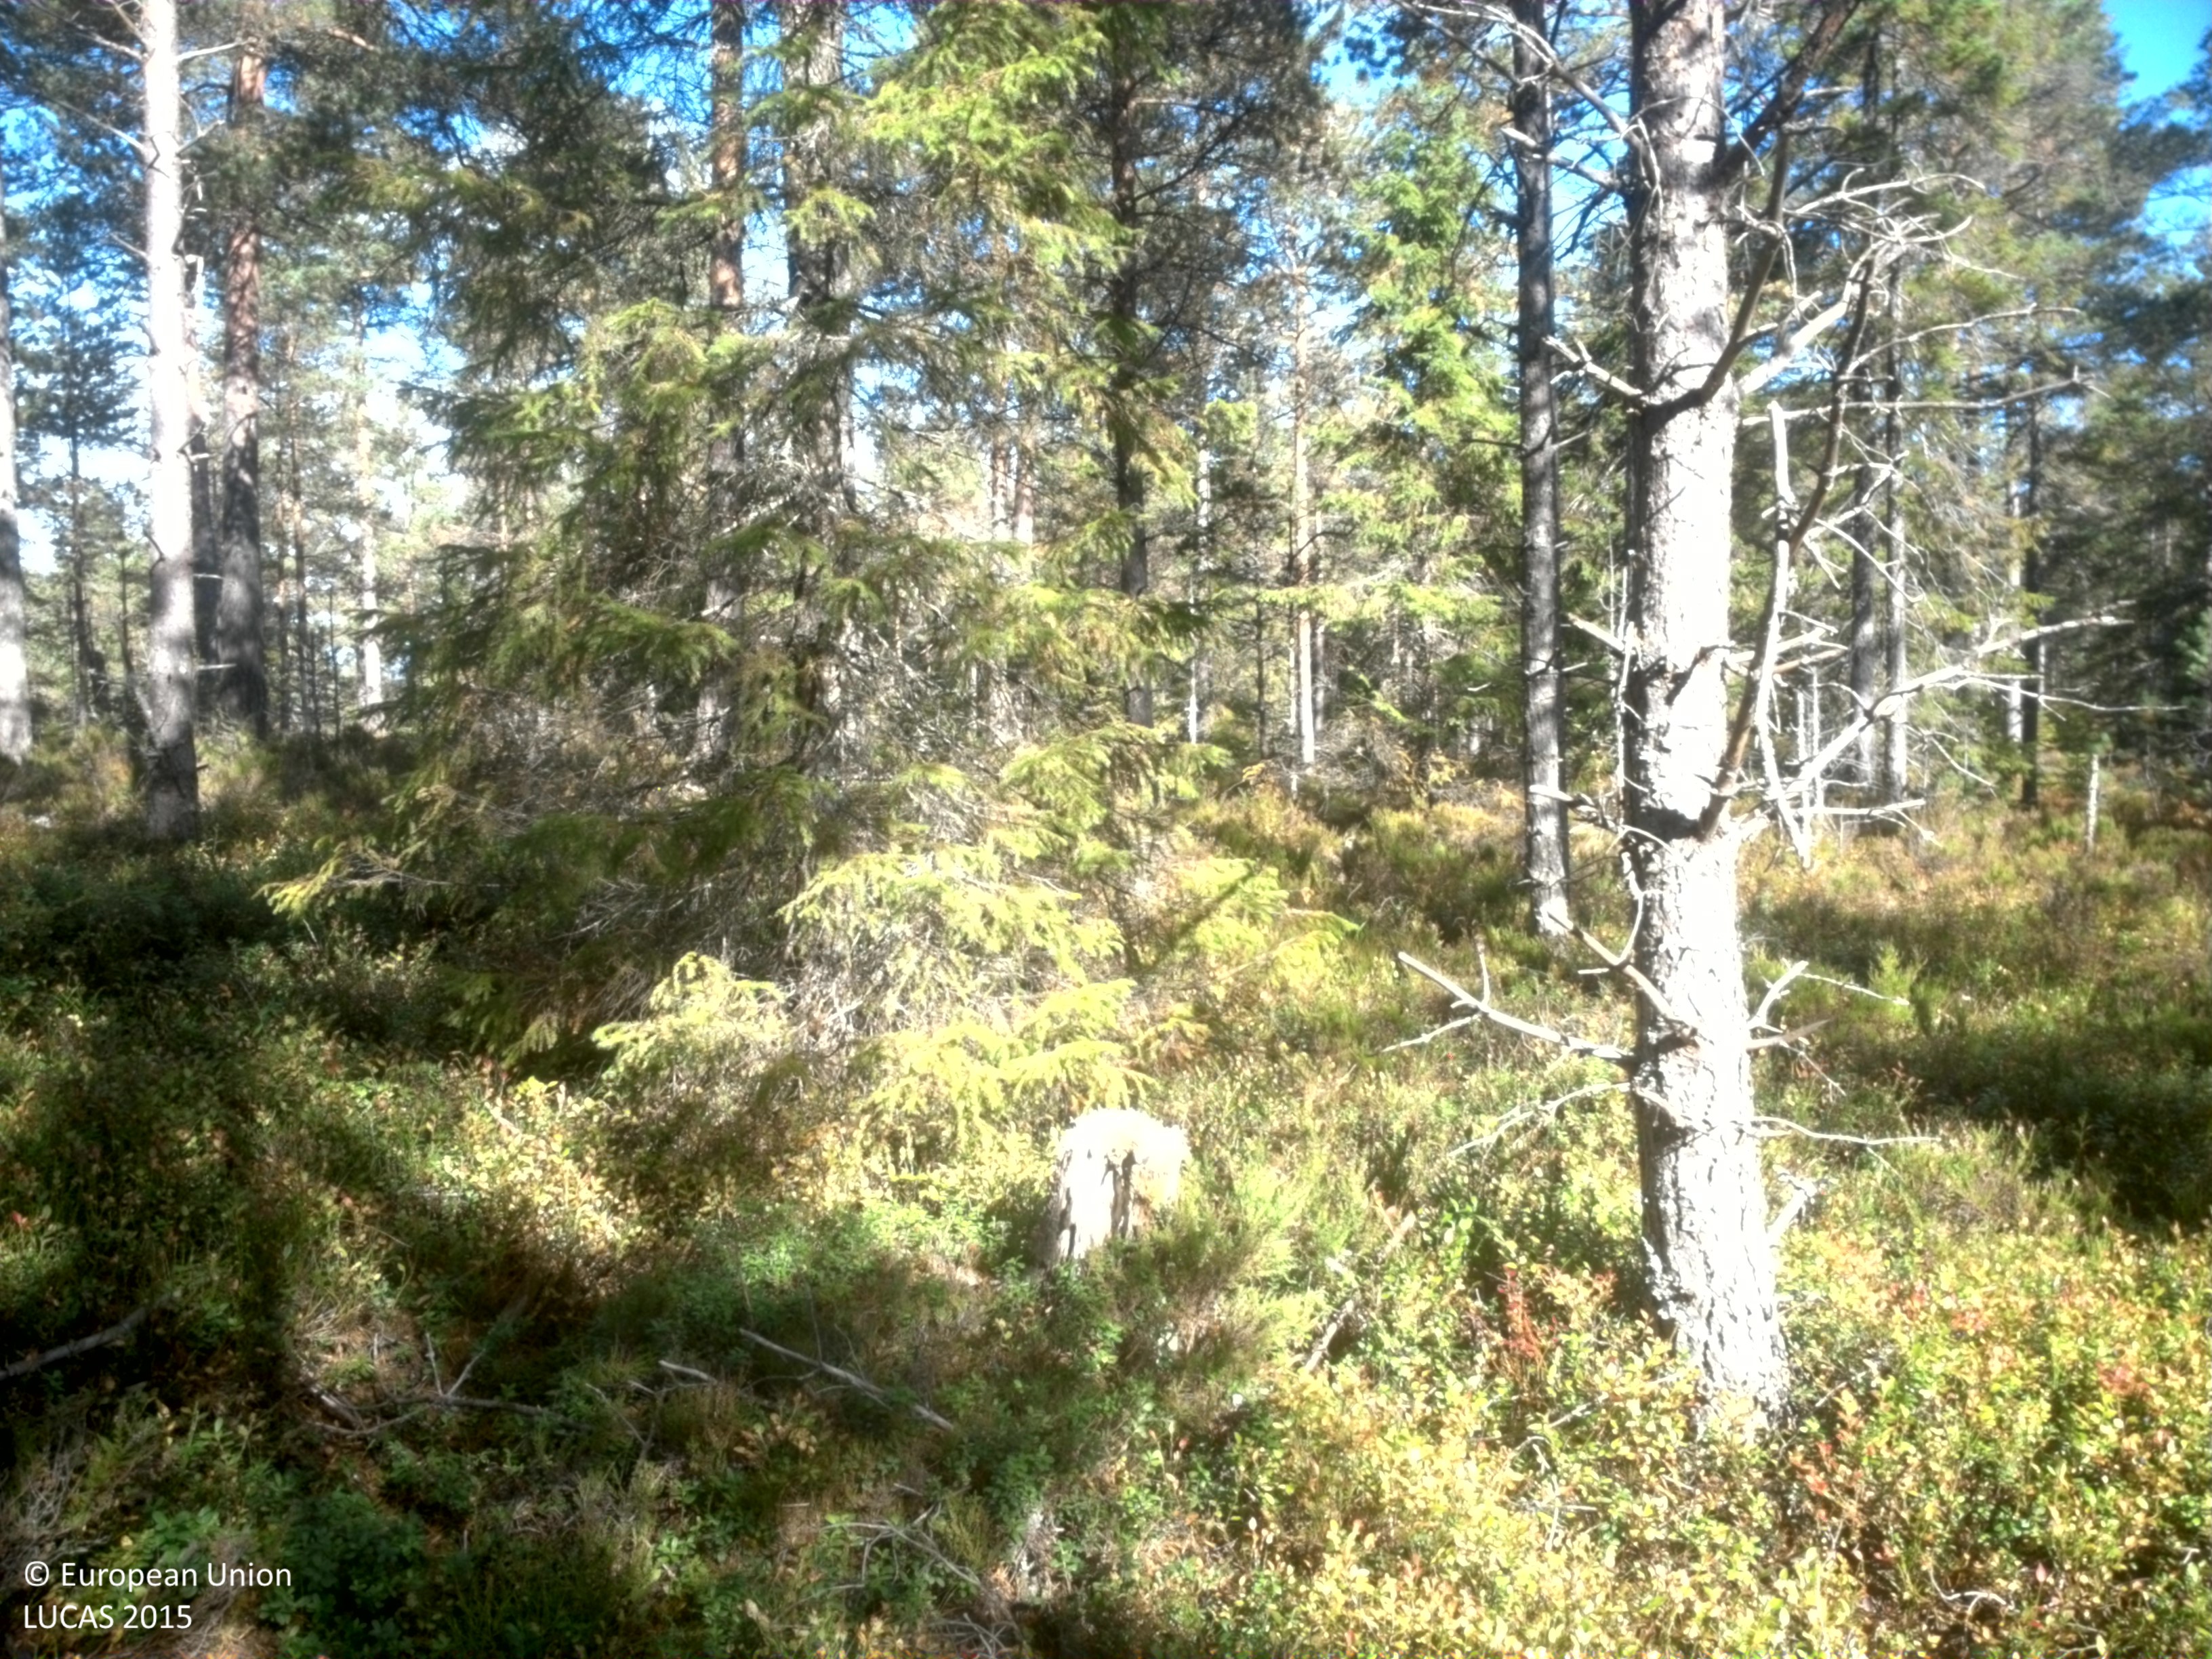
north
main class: Woodland
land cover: Other coniferous woodland
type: boreal forest
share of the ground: > 75 %
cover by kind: coniferous forest trees 75 %, shrubs 20 %, lichens and mosses 5 %
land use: Forestry
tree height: > 5 m
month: September
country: SE
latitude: 59.8688
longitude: 15.1869
